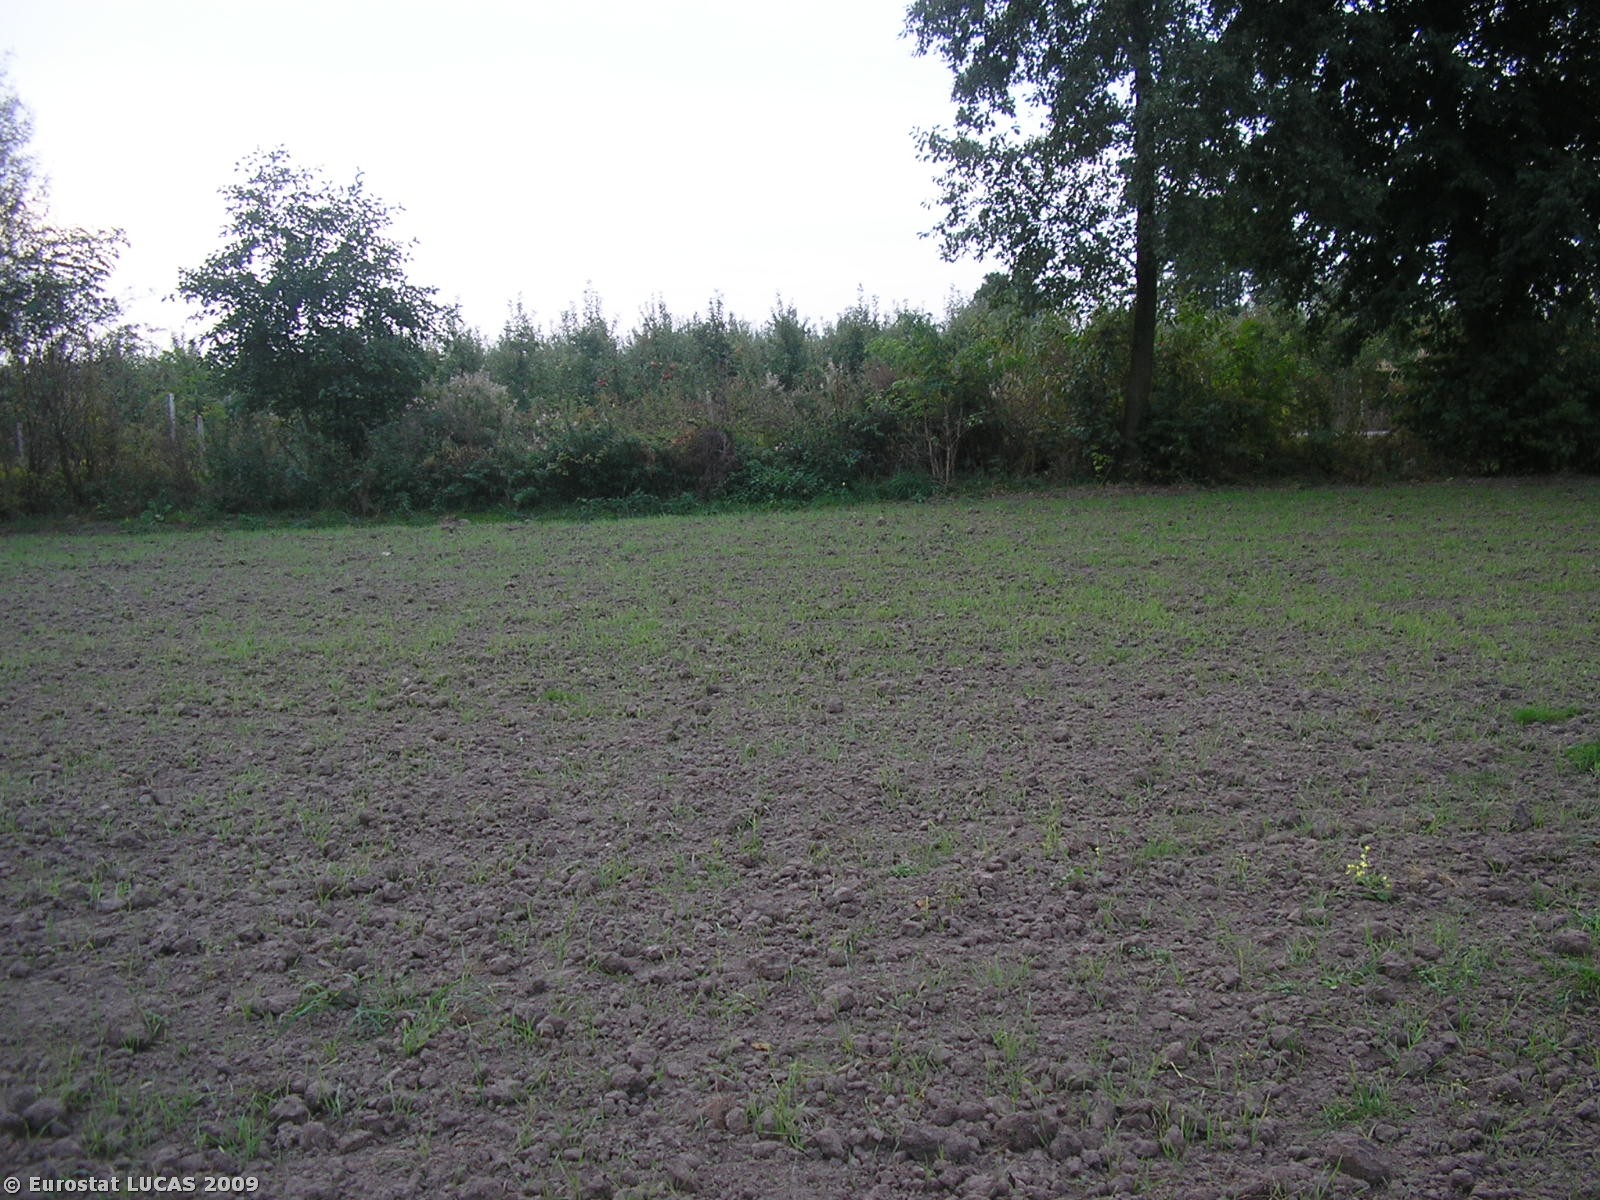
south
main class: Cropland
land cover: Triticale
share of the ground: < 10 %
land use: Agriculture (excluding fallow land and kitchen gardens)
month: September
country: PL
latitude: 51.7928
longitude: 20.9910
